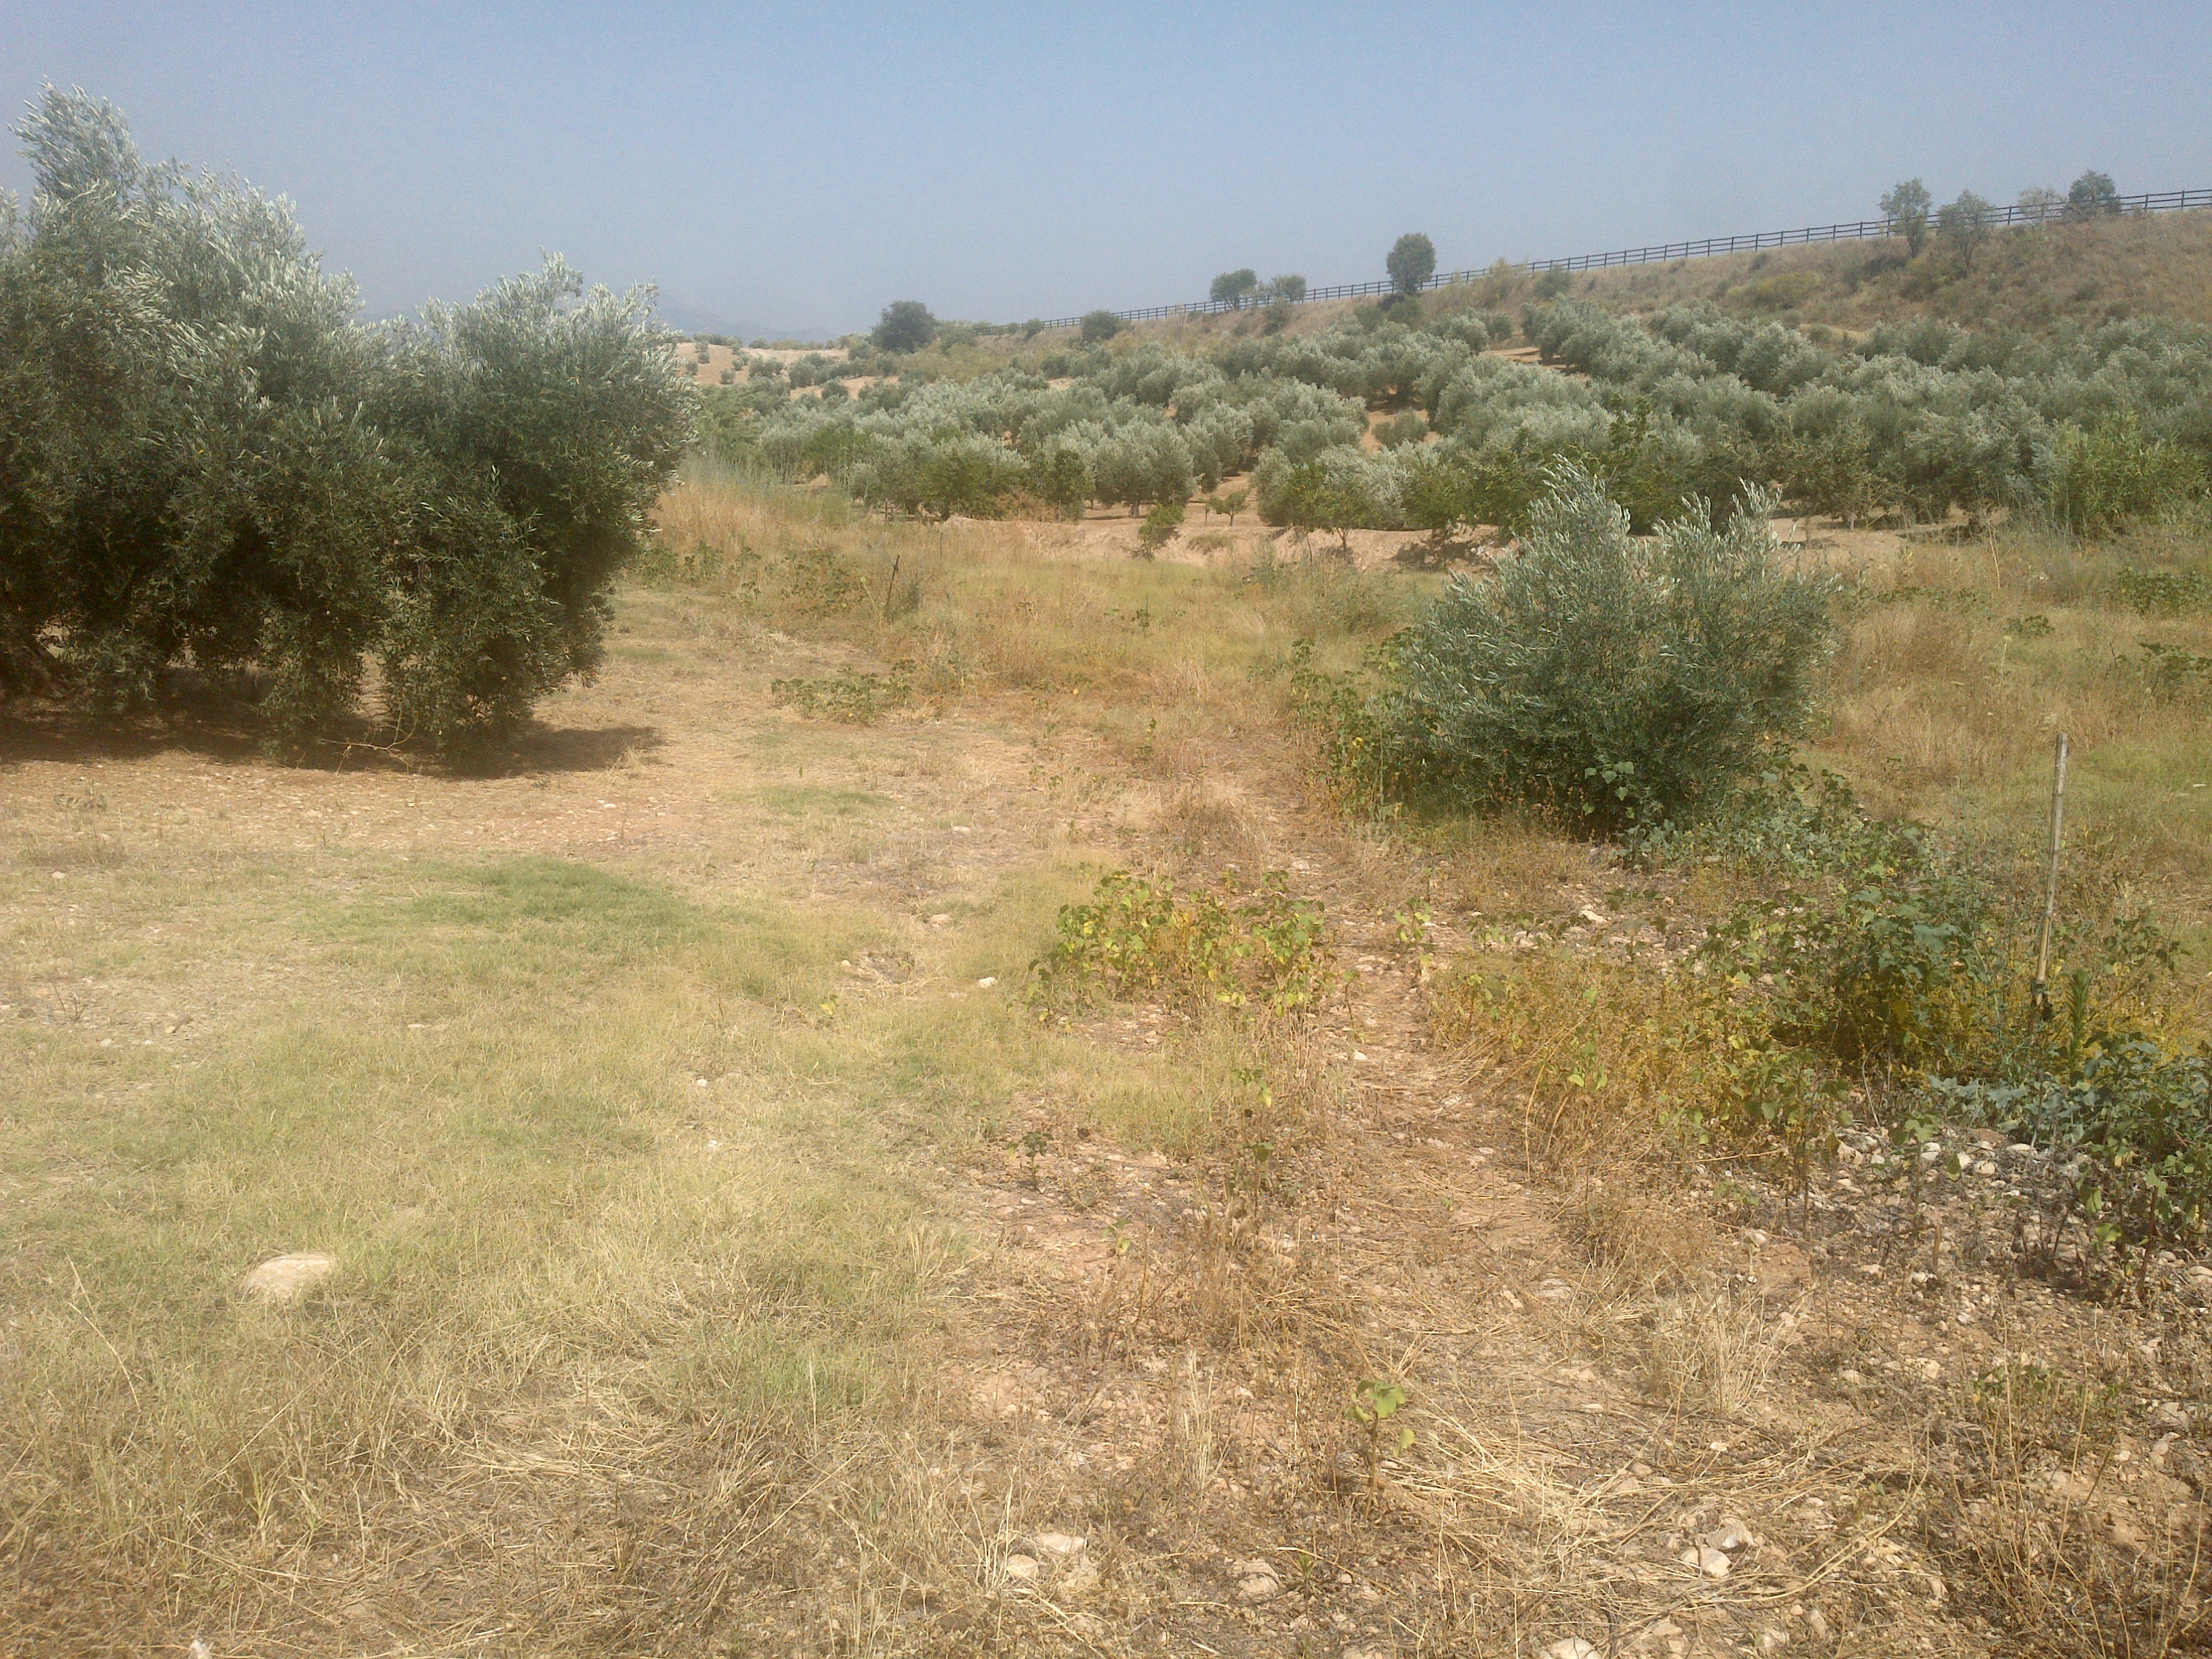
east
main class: Cropland
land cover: Olive groves
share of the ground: 25 - 50 %
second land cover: Spontaneously vegetated surfaces
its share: 10 - 25 %
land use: Agriculture (excluding fallow land and kitchen gardens)
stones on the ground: 25 - 50 %
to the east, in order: Olive groves; Spontaneously vegetated surfaces; Grass margins; Rivers and streams; Olive groves; Shruby margins
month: June
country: ES
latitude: 37.5714
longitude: -4.2345
